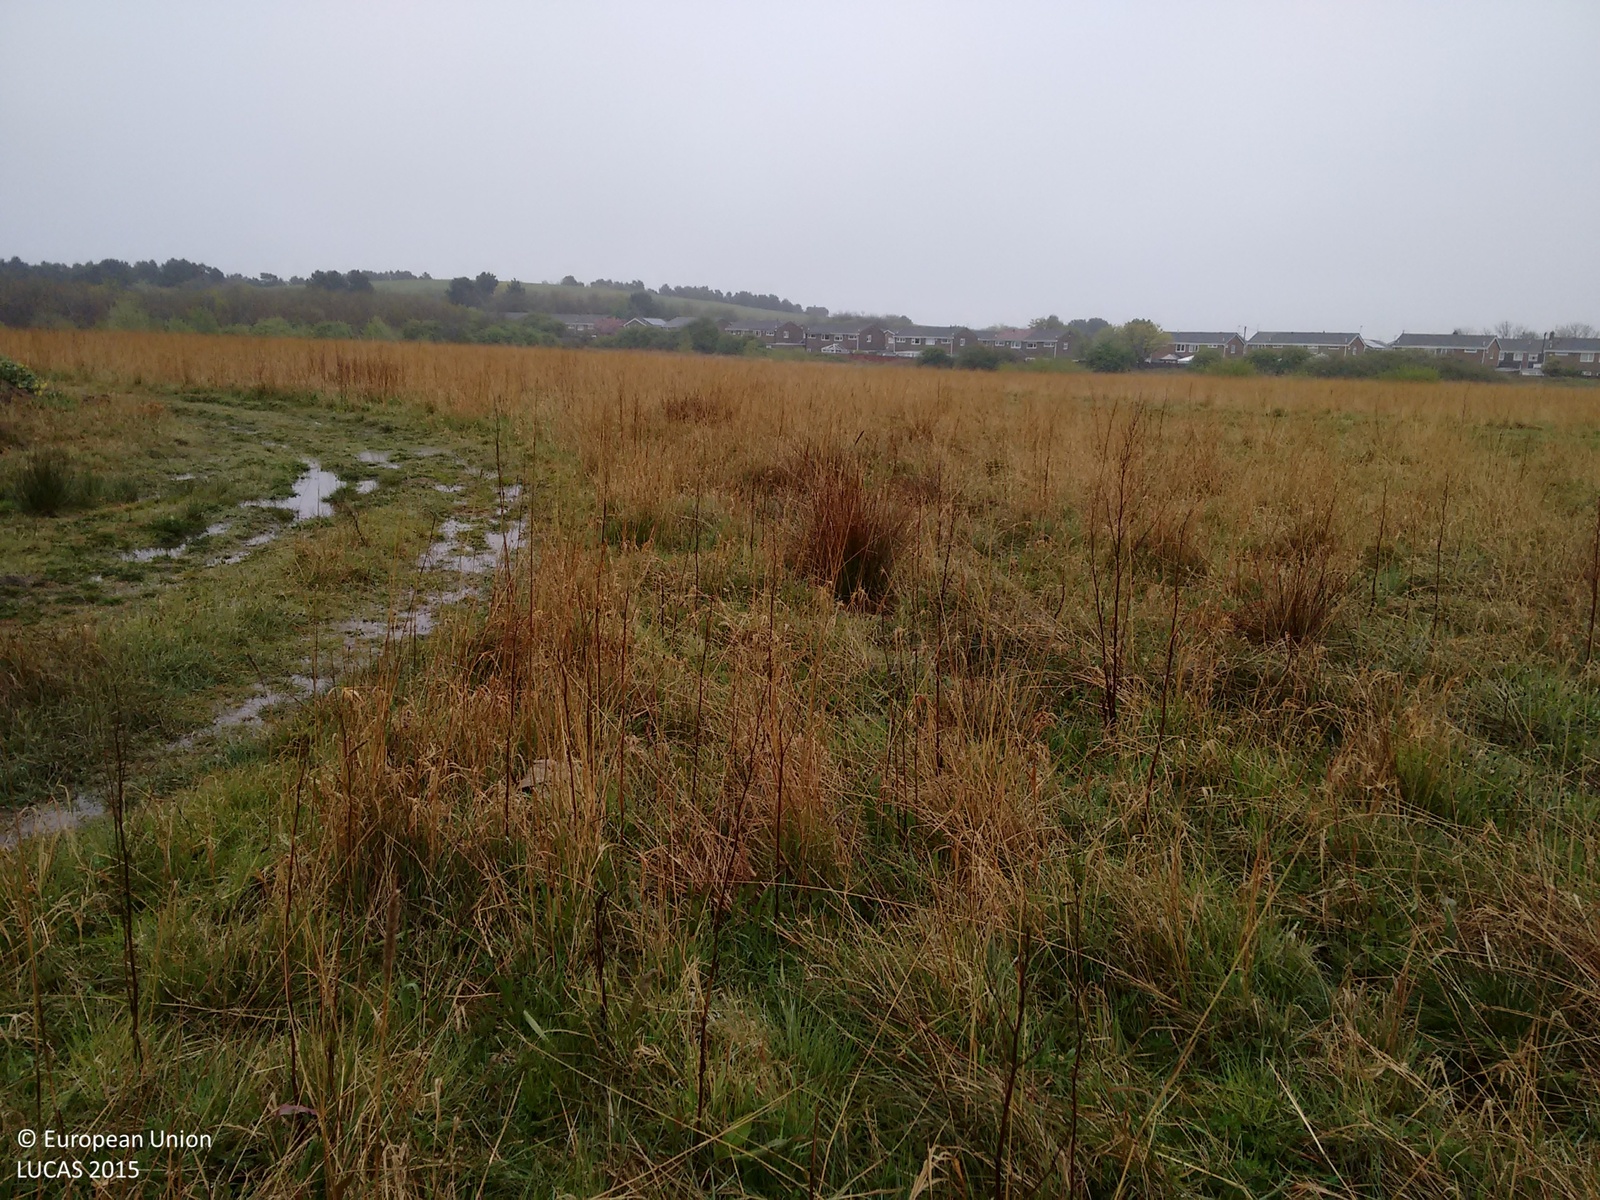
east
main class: Grassland
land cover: Grassland without tree/shrub cover
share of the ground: > 75 %
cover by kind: herbaceous plants 100 %
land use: Abandoned areas
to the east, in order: Grassland without tree/shrub cover; Tracks; Grassland without tree/shrub cover; Broadleaved woodland; Tracks; Broadleaved woodland
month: May
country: GB
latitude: 55.1197
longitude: -1.5407
